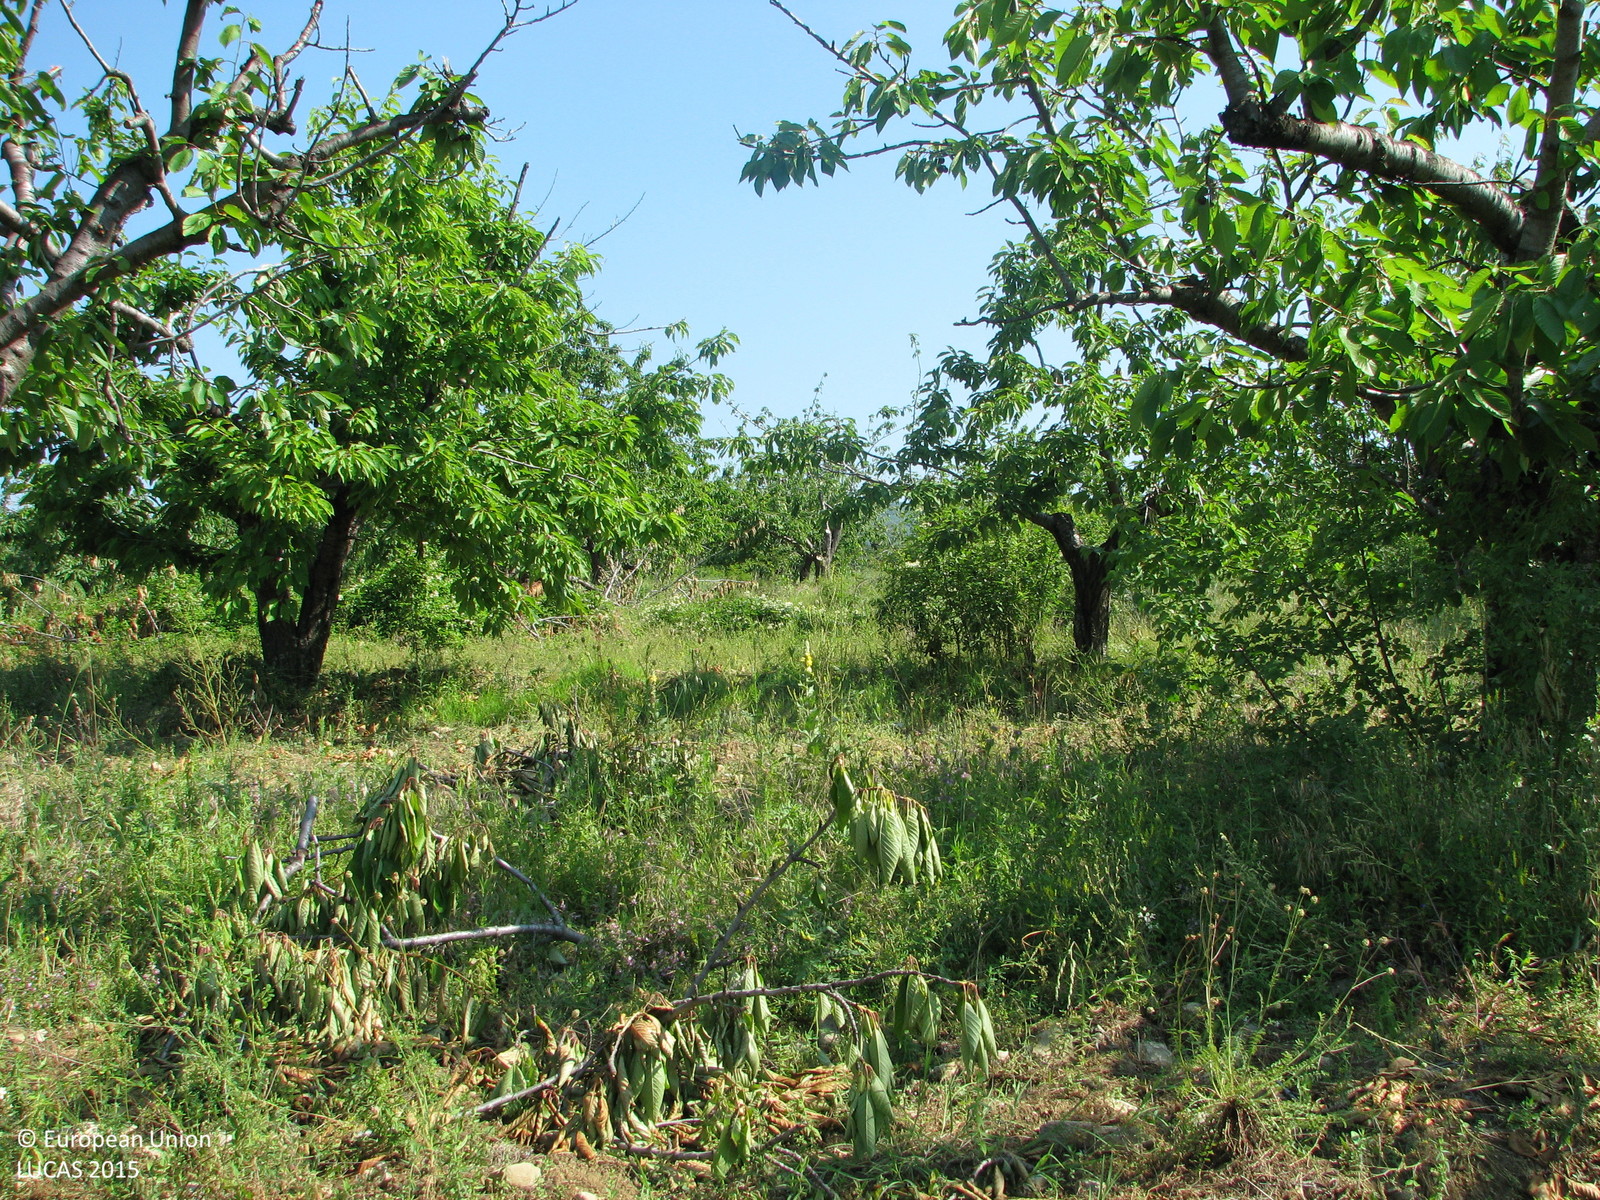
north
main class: Cropland
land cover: Cherry fruit
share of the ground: 25 - 50 %
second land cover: Spontaneously vegetated surfaces
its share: > 75 %
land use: Agriculture (excluding fallow land and kitchen gardens)
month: June
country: BG
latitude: 42.6449
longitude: 26.1990
